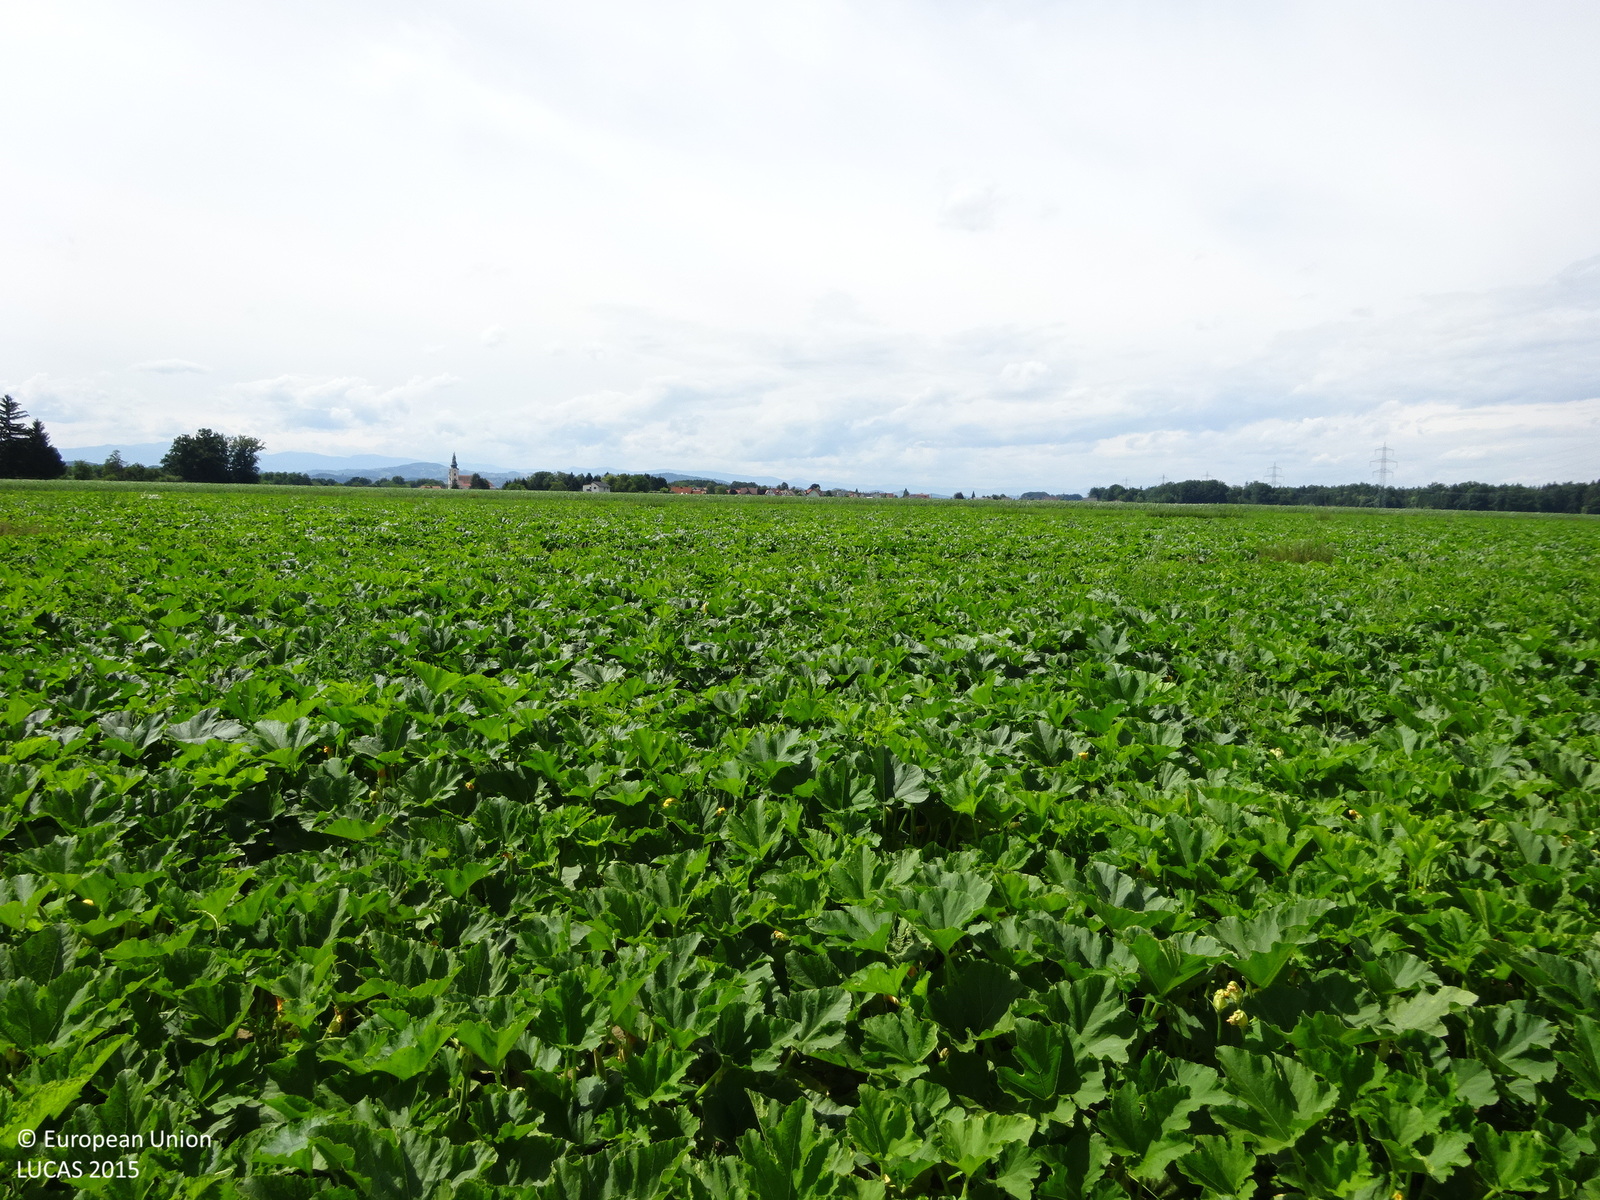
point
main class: Cropland
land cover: Other fibre and oleaginous crops
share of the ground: > 75 %
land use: Agriculture (excluding fallow land and kitchen gardens)
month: June
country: AT
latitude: 46.7439
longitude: 15.6408
